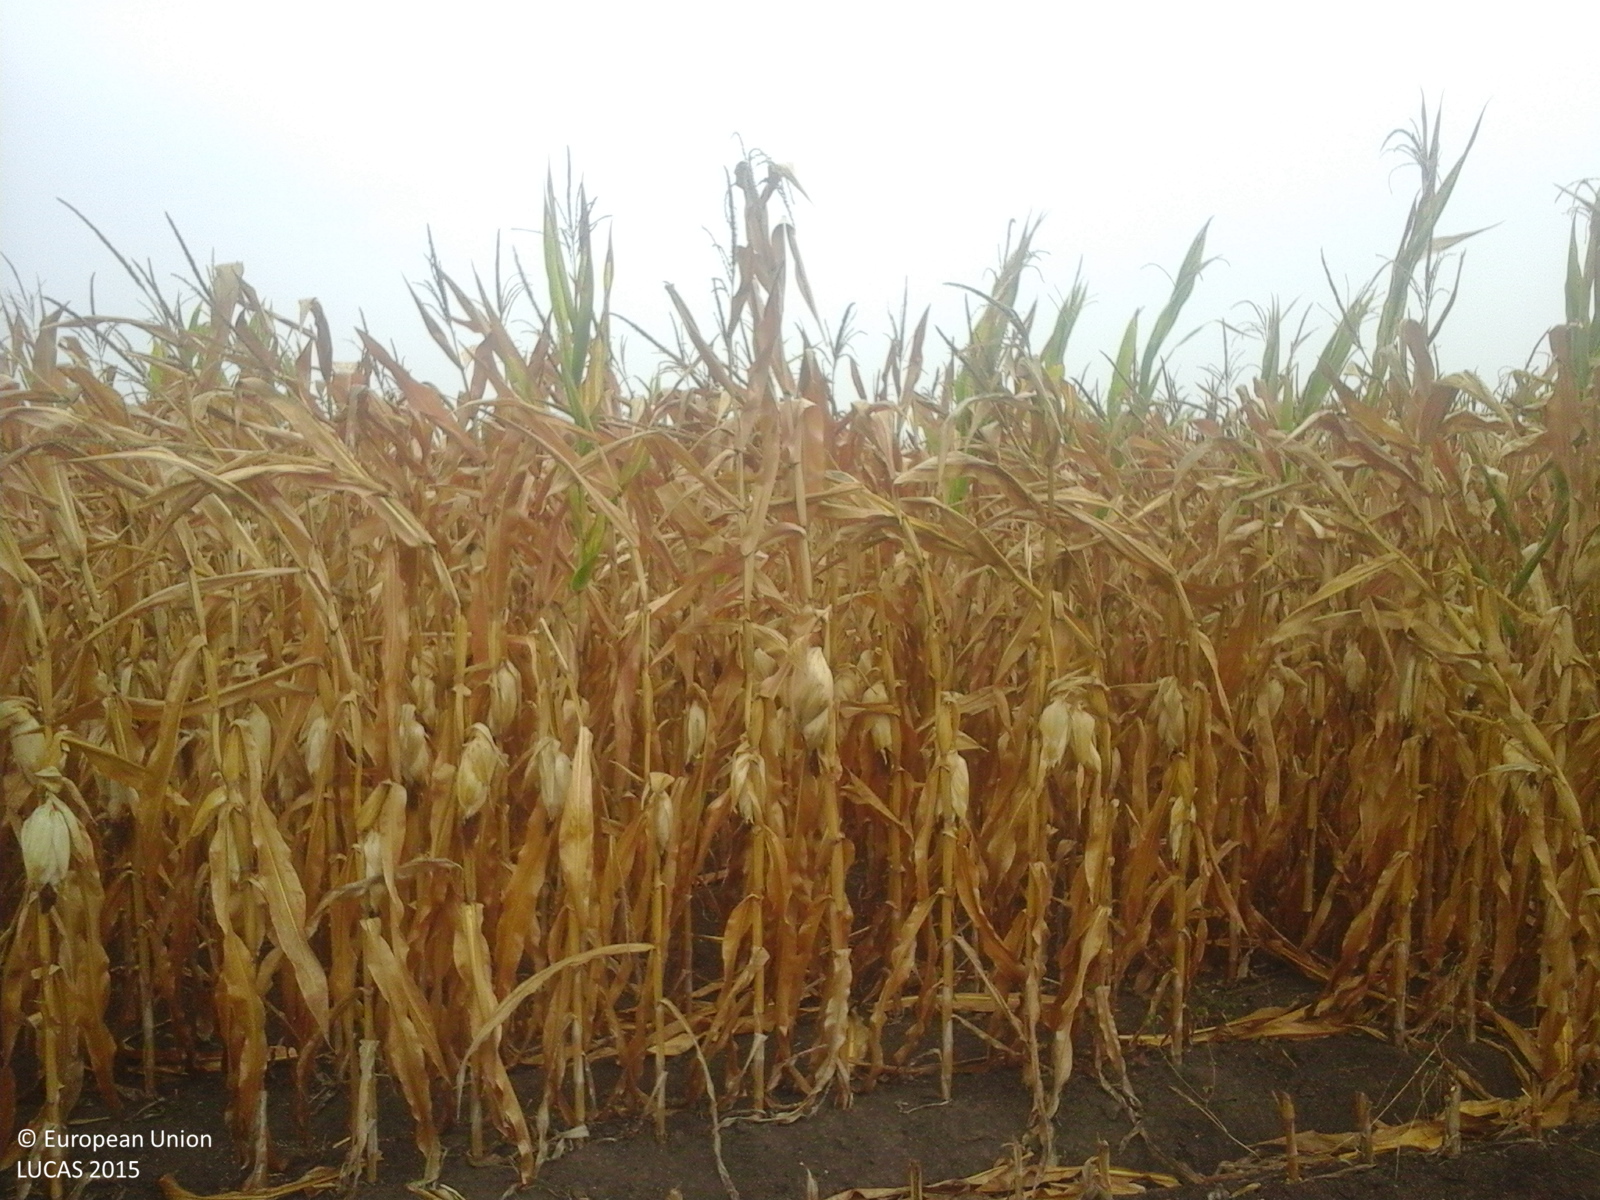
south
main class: Cropland
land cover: Maize
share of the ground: > 75 %
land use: Agriculture (excluding fallow land and kitchen gardens)
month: September
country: RO
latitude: 47.7007
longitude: 22.5722
